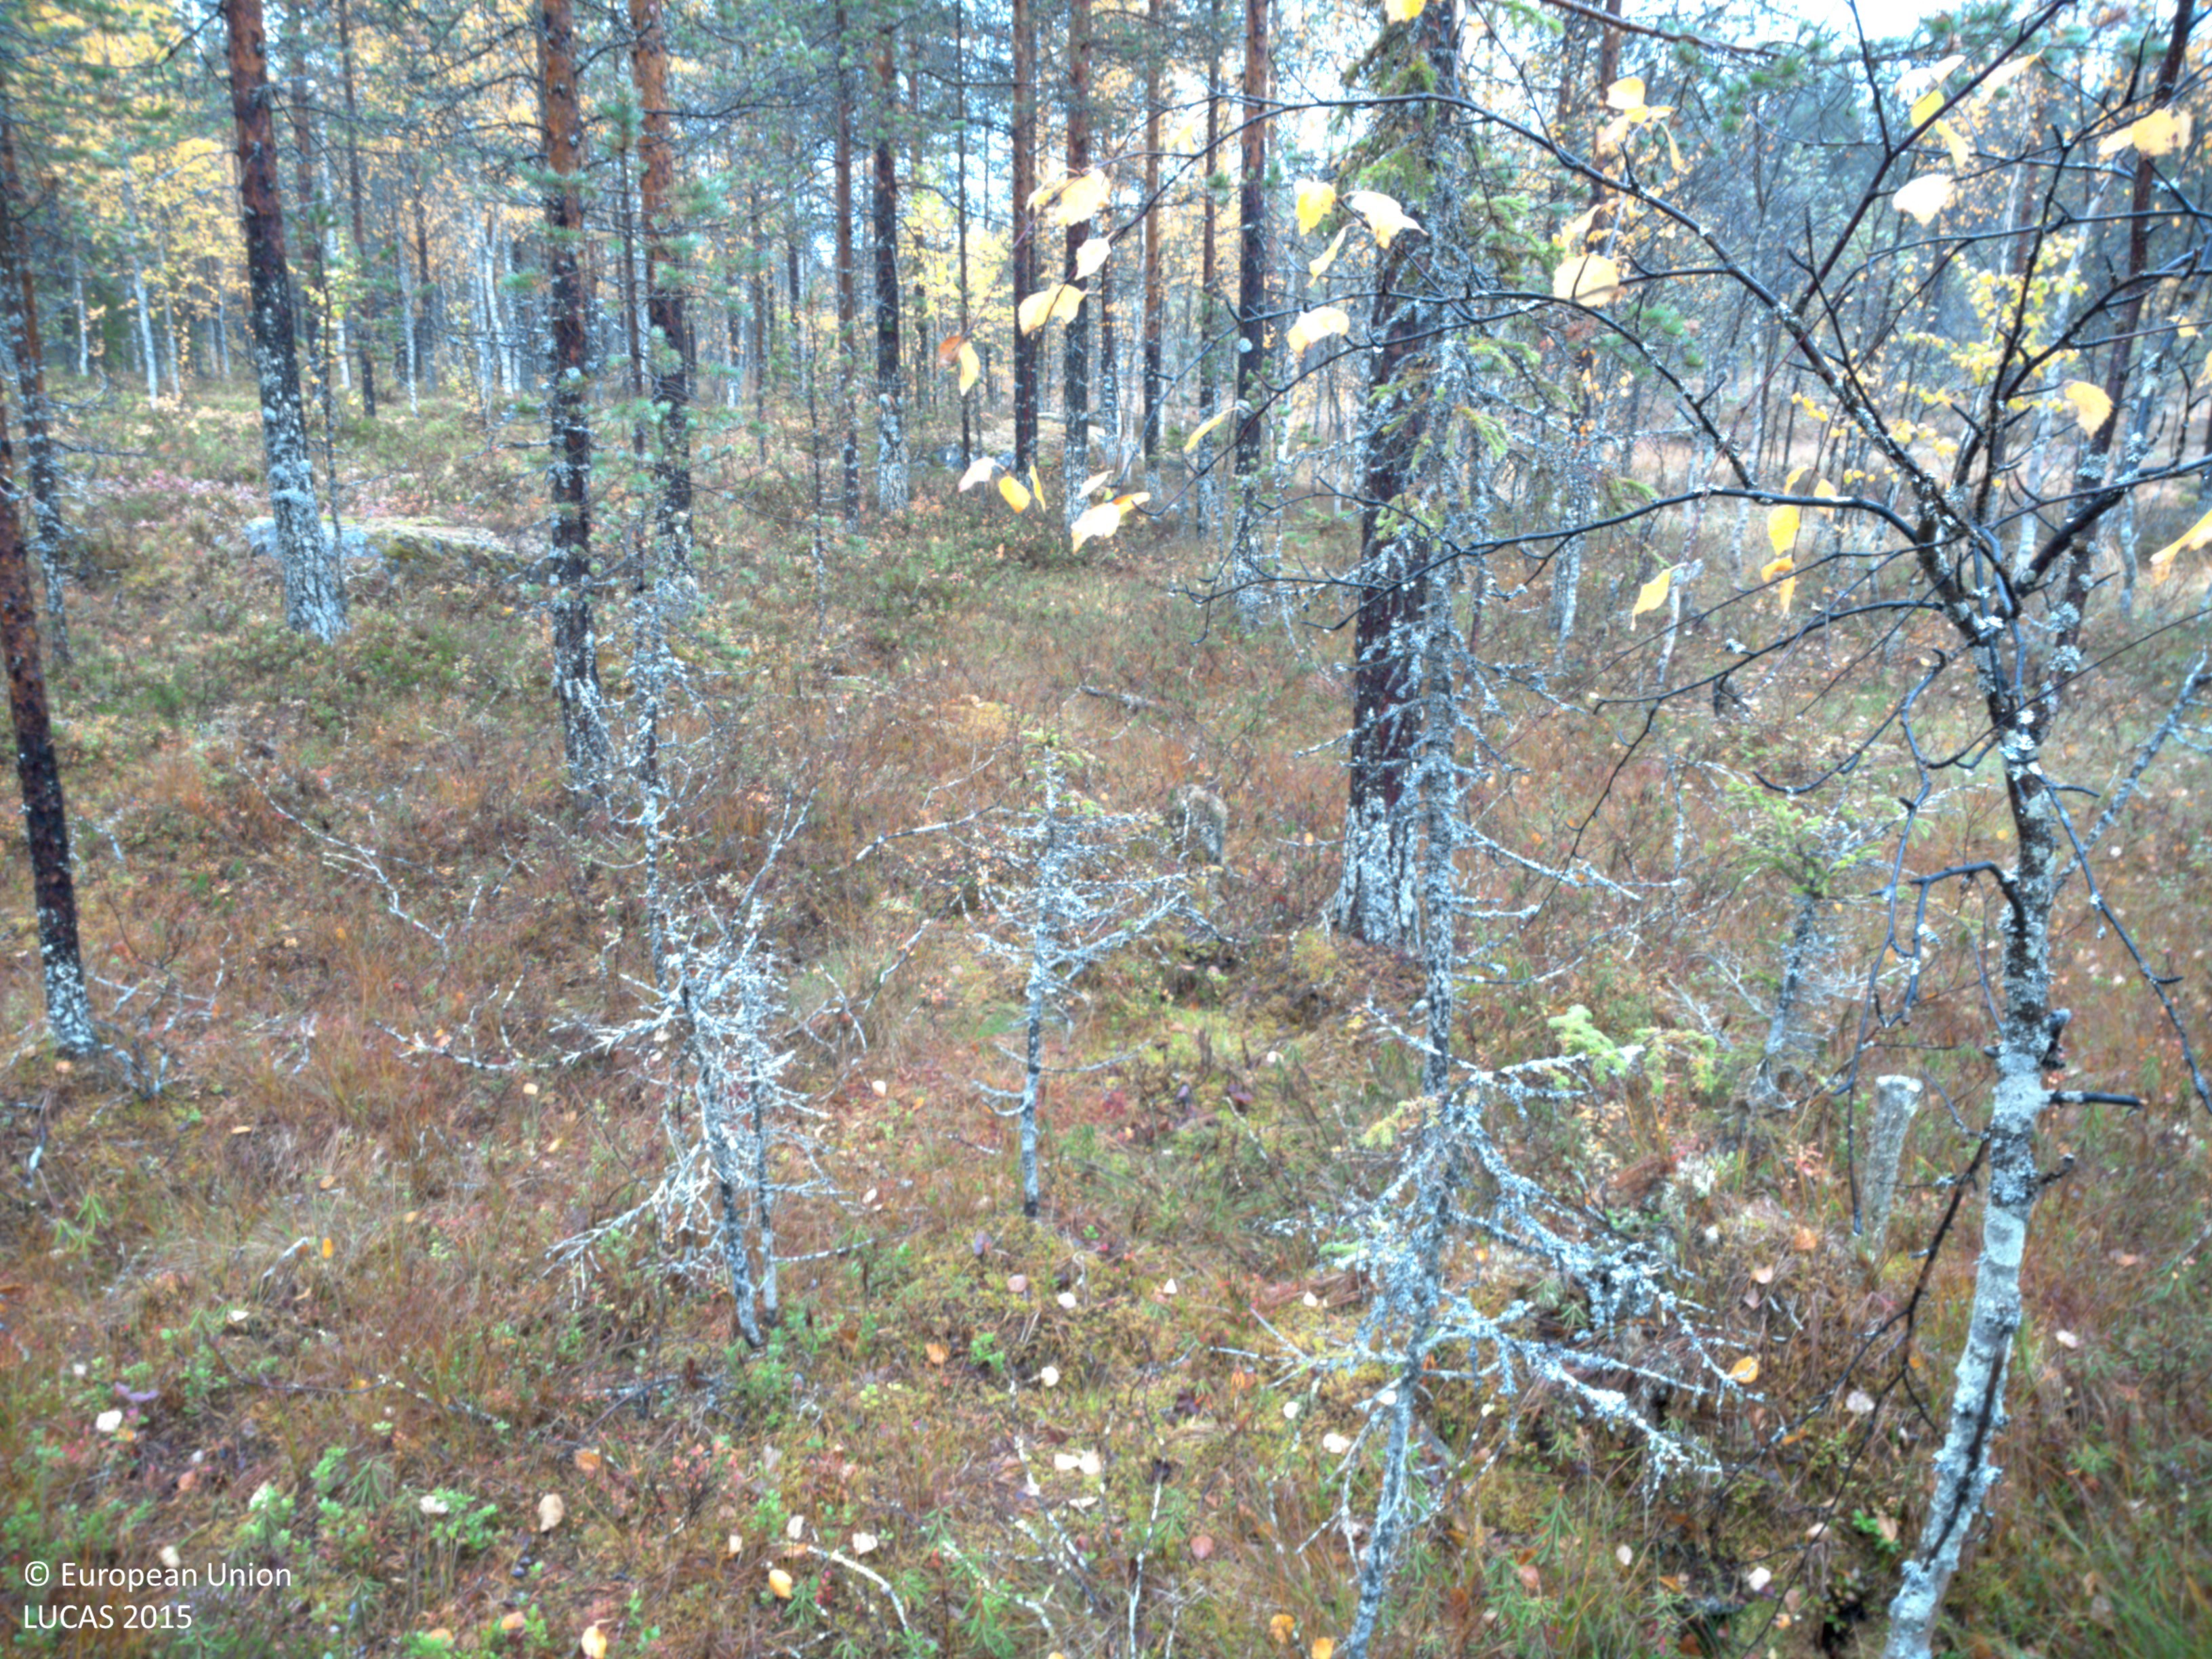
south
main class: Woodland
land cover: Pine dominated coniferous woodland
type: mire and swamp forests
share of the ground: 25 - 50 %
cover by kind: shrubs 35 %, coniferous forest trees 25 %, herbaceous plants 20 %, lichens and mosses 15 %, broadleaved forest trees 5 %
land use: Forestry
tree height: > 5 m
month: September
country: SE
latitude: 64.9718
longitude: 19.1389
